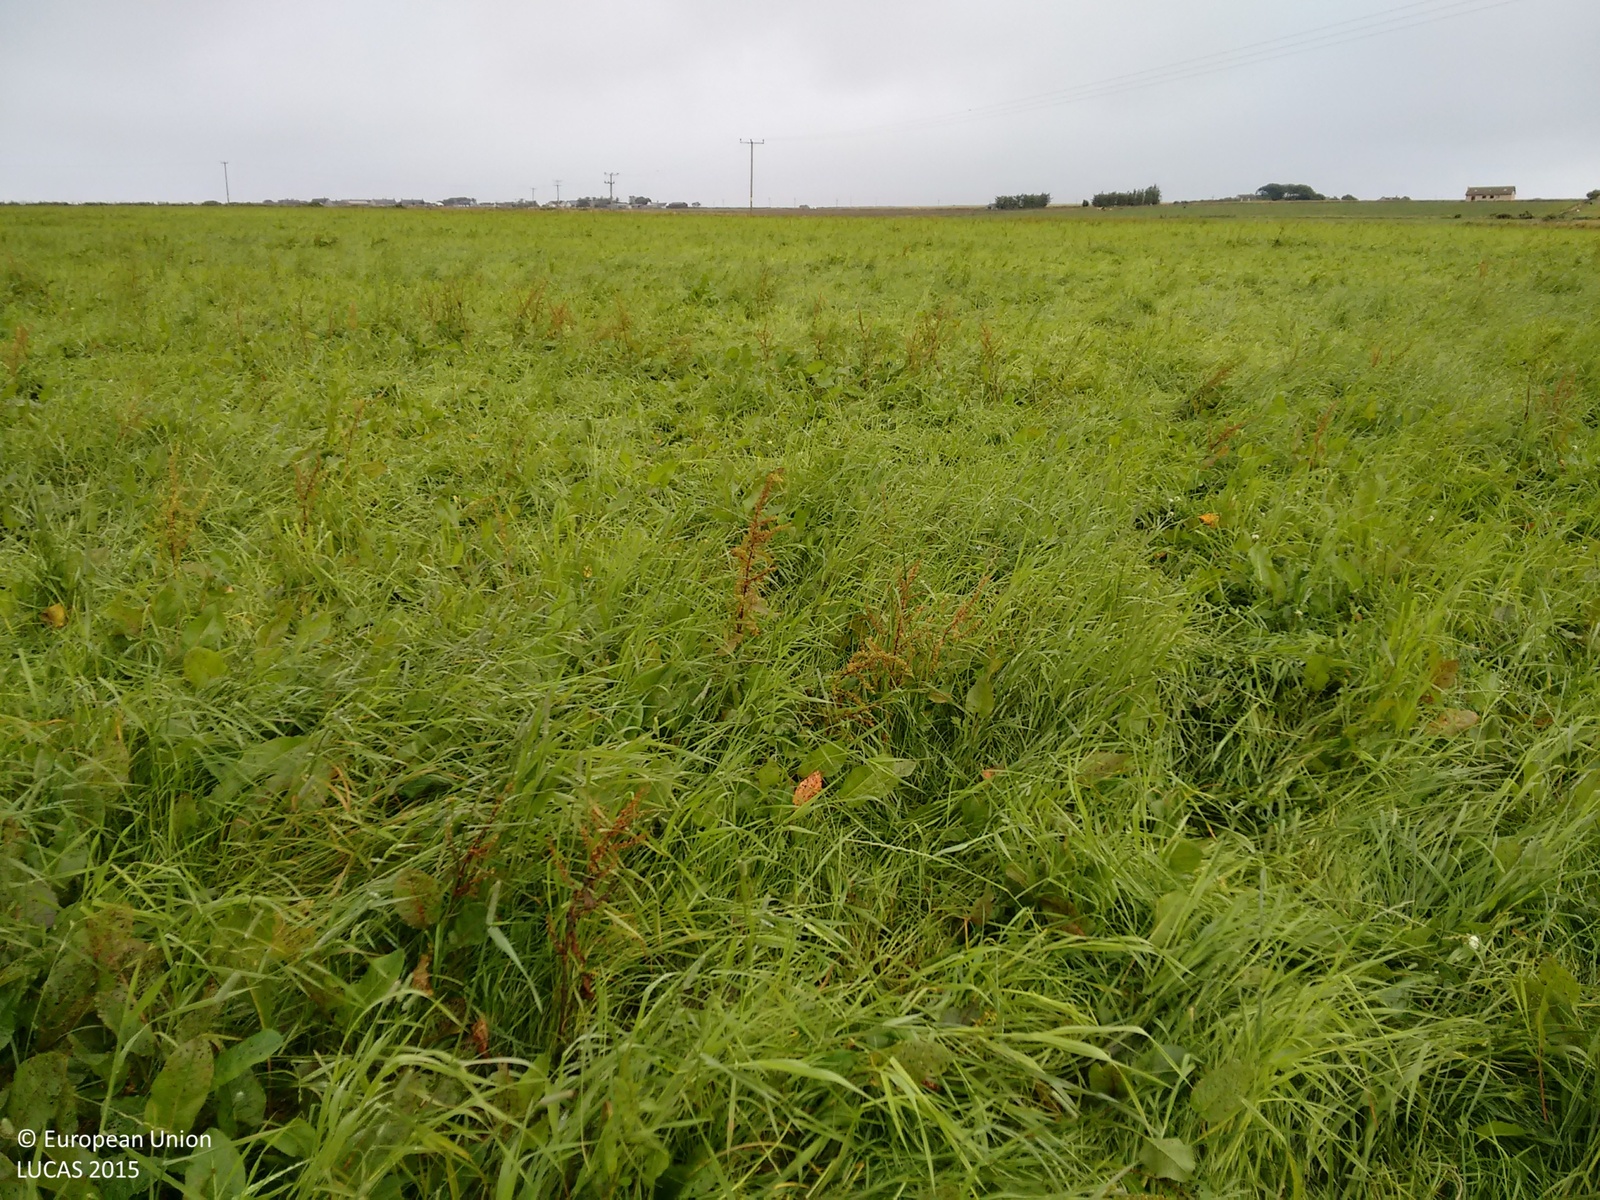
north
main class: Grassland
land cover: Grassland without tree/shrub cover
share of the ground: > 75 %
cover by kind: herbaceous plants 100 %
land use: Agriculture (excluding fallow land and kitchen gardens)
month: August
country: GB
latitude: 58.4659
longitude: -3.1380
